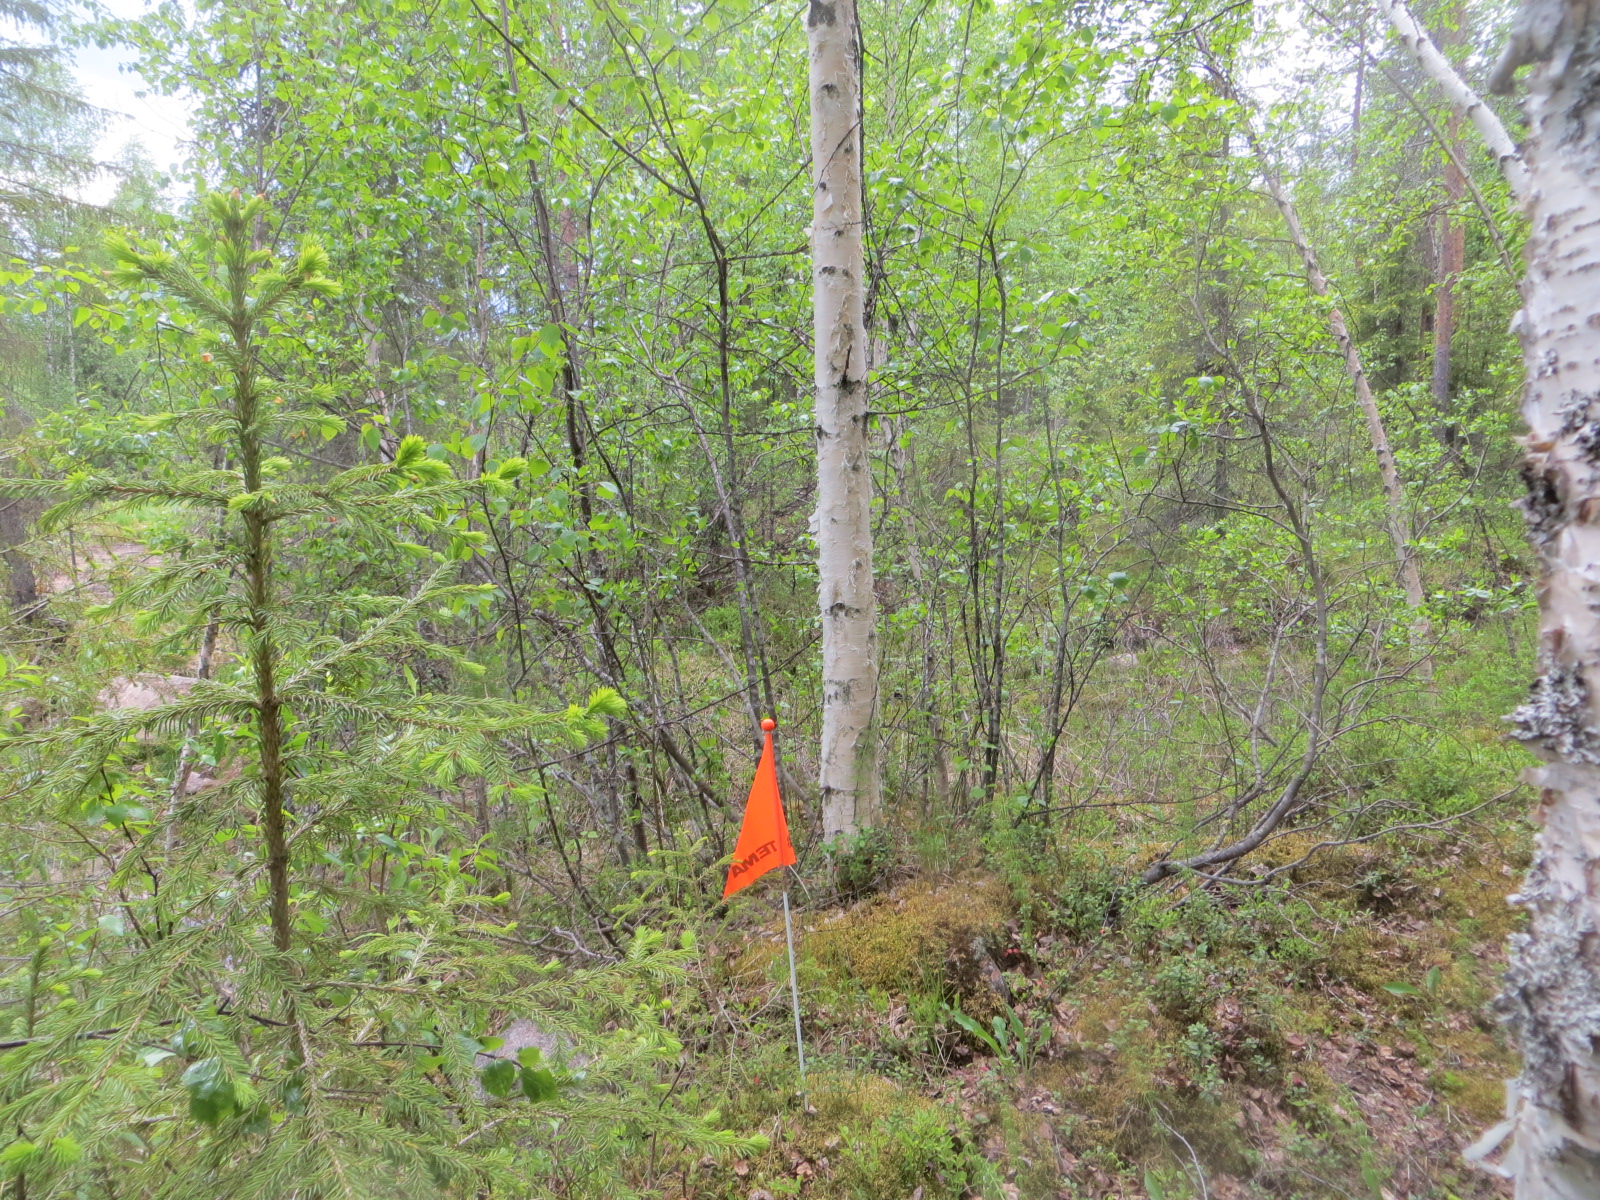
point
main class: Woodland
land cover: Other mixed woodland
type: boreal forest
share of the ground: > 75 %
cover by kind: broadleaved forest trees 45 %, coniferous forest trees 30 %, shrubs 20 %, lichens and mosses 5 %
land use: Forestry
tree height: > 5 m
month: June
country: FI
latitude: 66.6321
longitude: 25.2627
